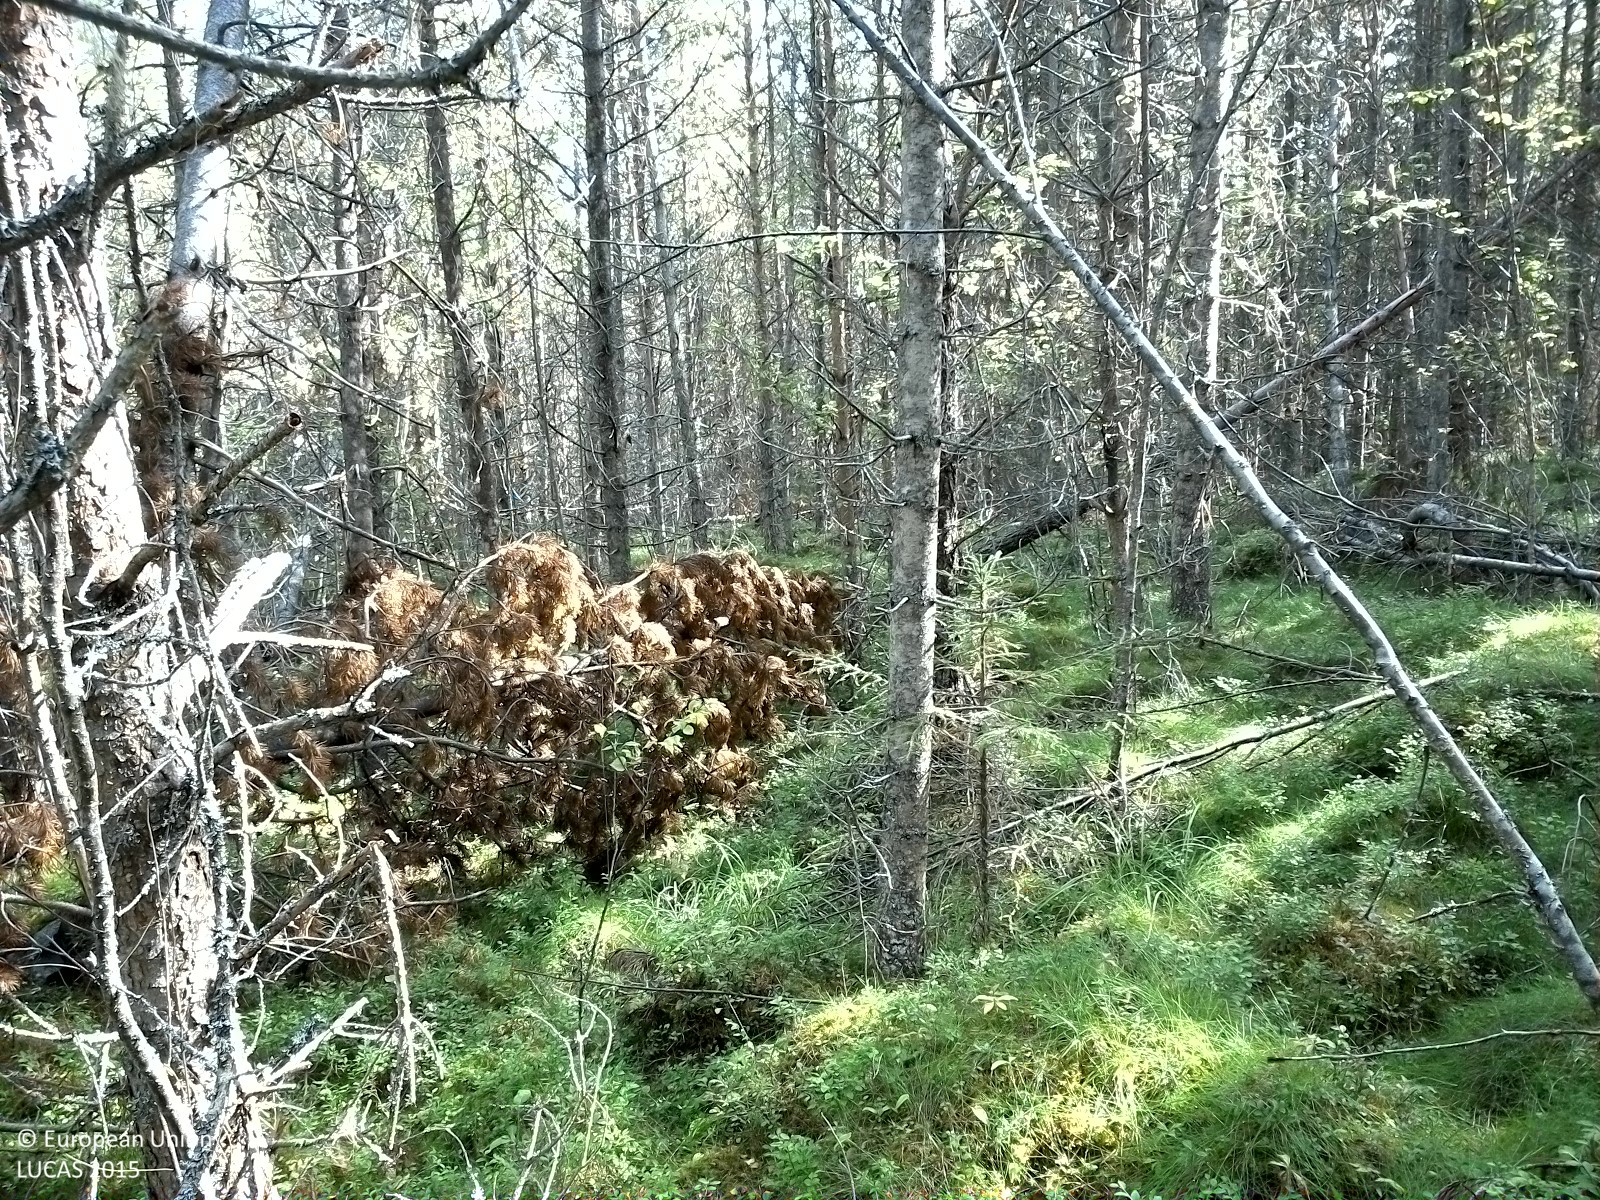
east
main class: Woodland
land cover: Pine dominated coniferous woodland
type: exotic forest
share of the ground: 50 - 75 %
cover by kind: coniferous forest trees 70 %, shrubs 10 %, herbaceous plants 10 %, lichens and mosses 10 %
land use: Forestry
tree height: > 5 m
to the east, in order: Pine dominated coniferous woodland; Pine dominated mixed woodland; Other mixed woodland; Rivers and streams; Other mixed woodland; Broadleaved woodland; Ditches and canals; Paved roads, cycling and walking lanes; Ditches and canals; Broadleaved woodland; Spruce dominated coniferous woodland
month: September
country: SE
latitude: 62.5676
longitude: 16.3801
